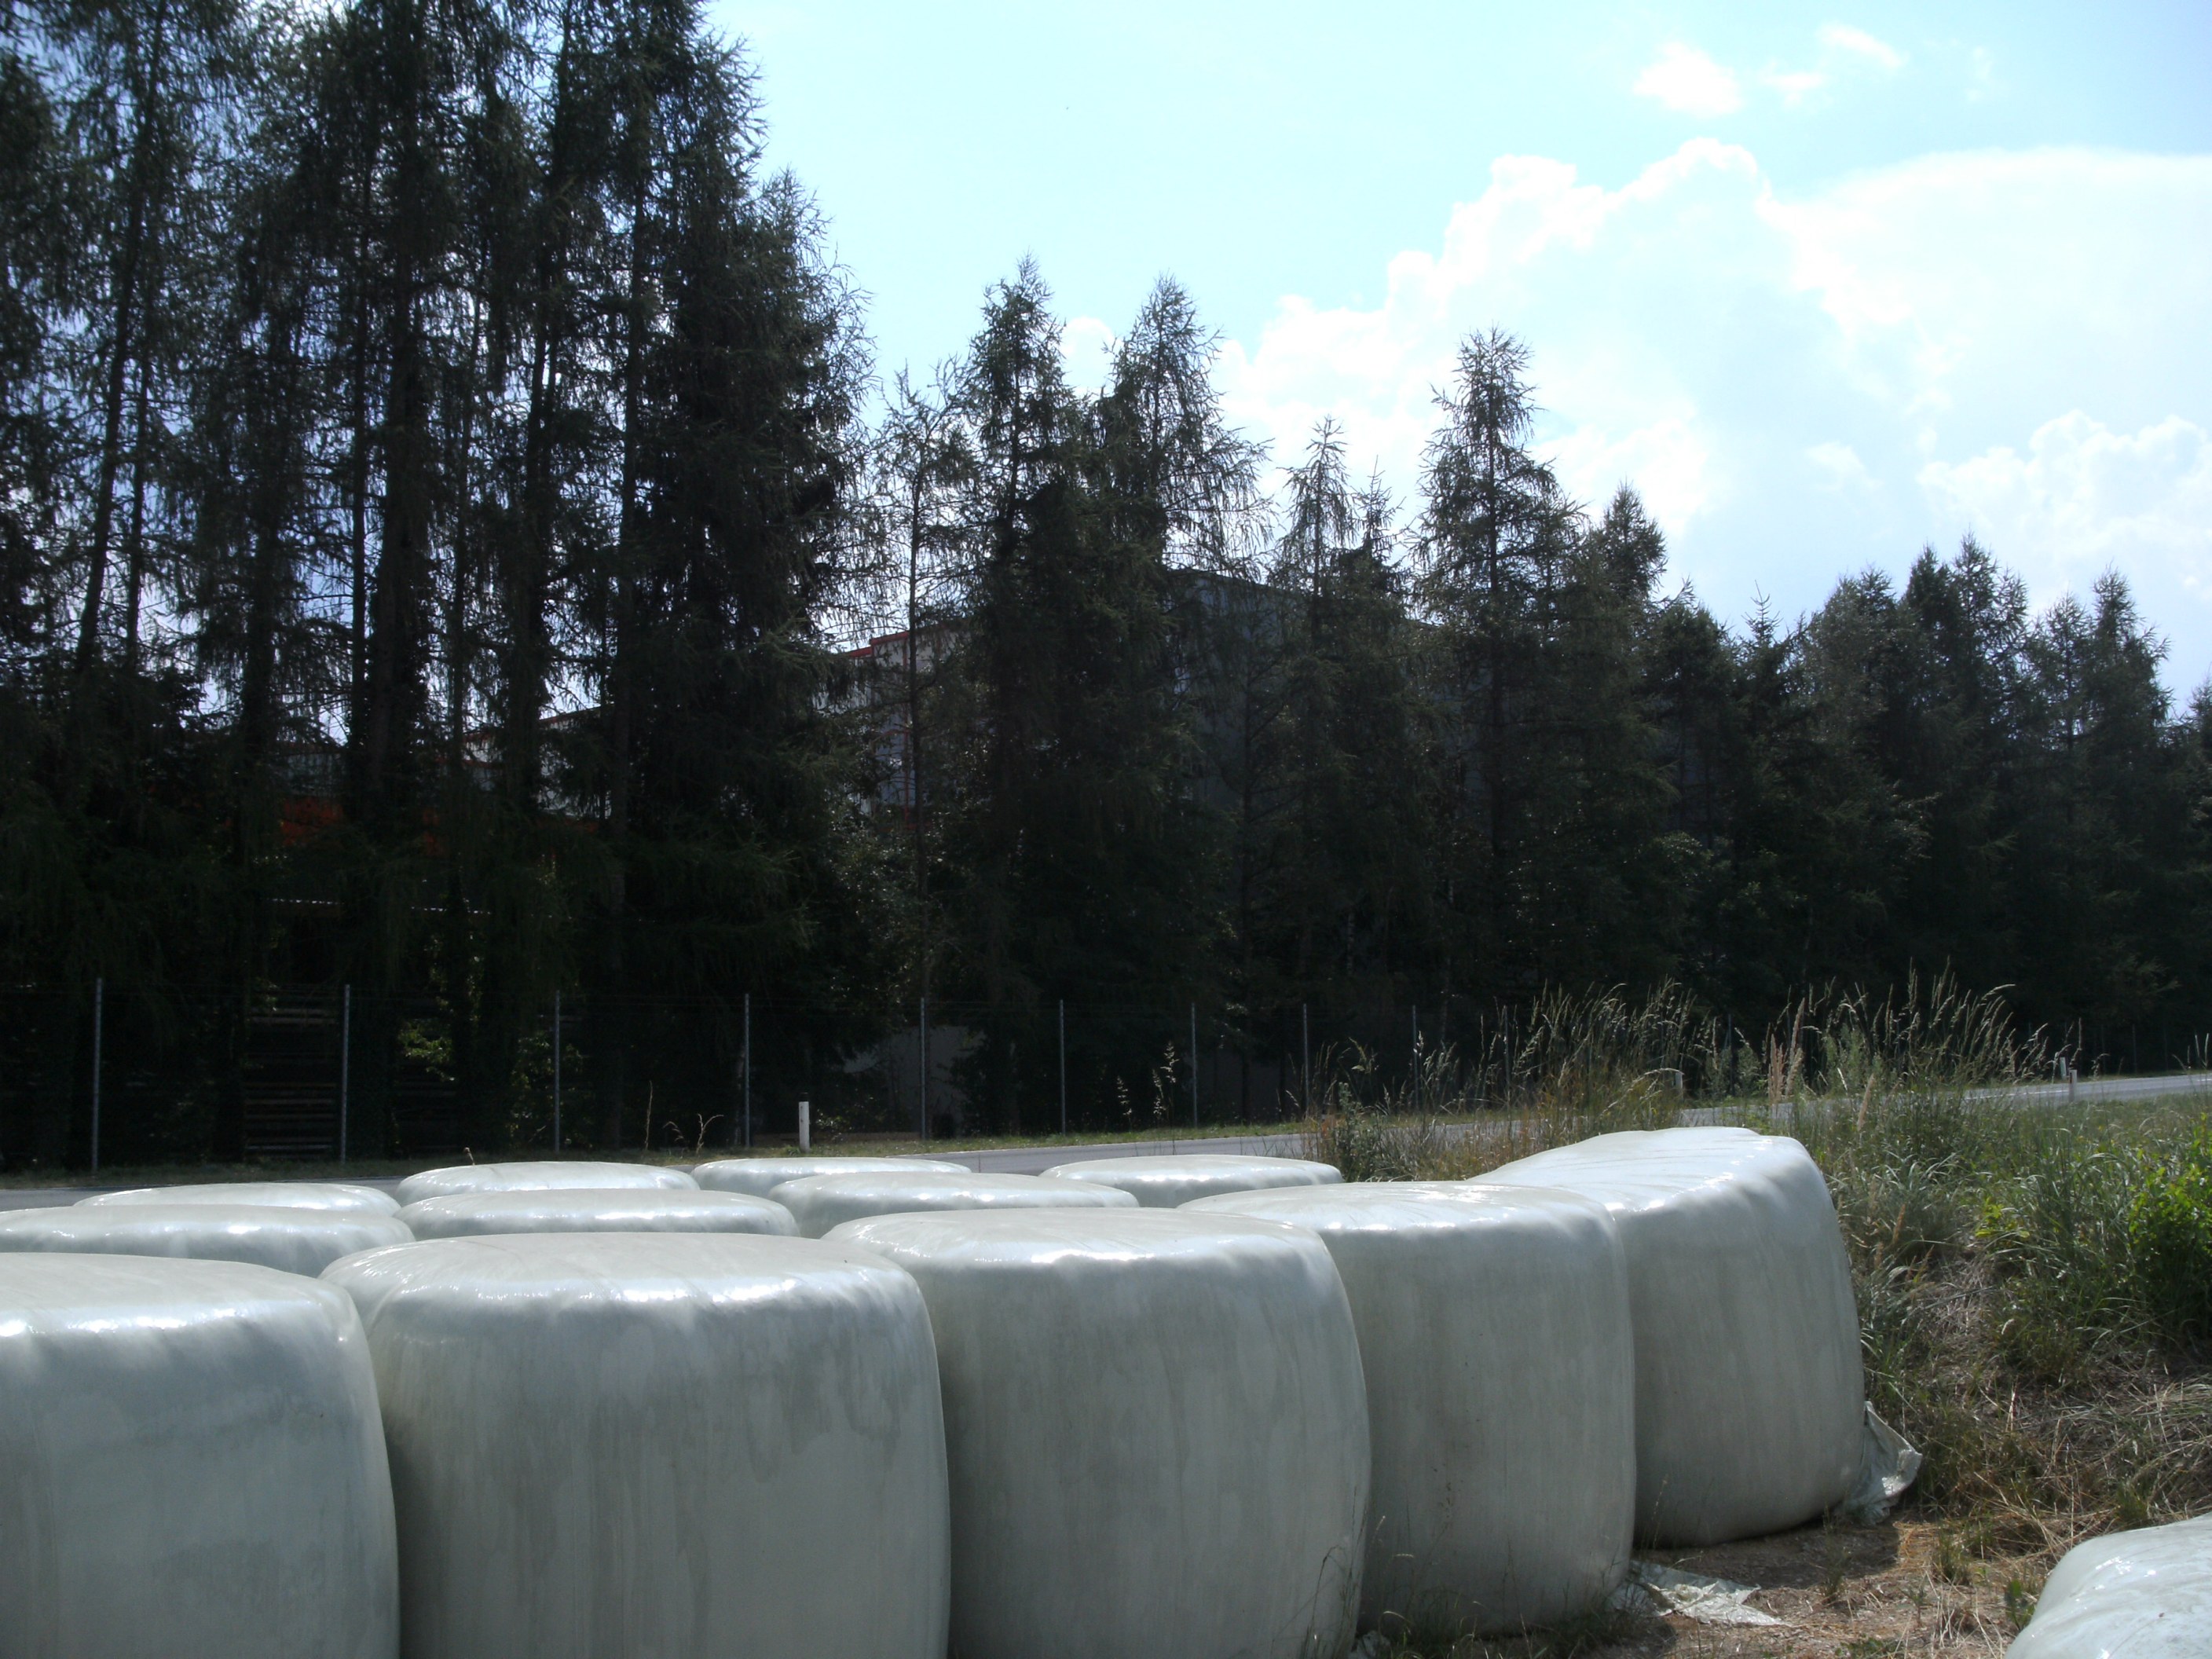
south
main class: Grassland
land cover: Grassland without tree/shrub cover
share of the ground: > 75 %
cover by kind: herbaceous plants 80 %, unconsolidated bare surface 20 %
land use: Agriculture (excluding fallow land and kitchen gardens)
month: July
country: AT
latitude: 46.6575
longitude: 14.8201
